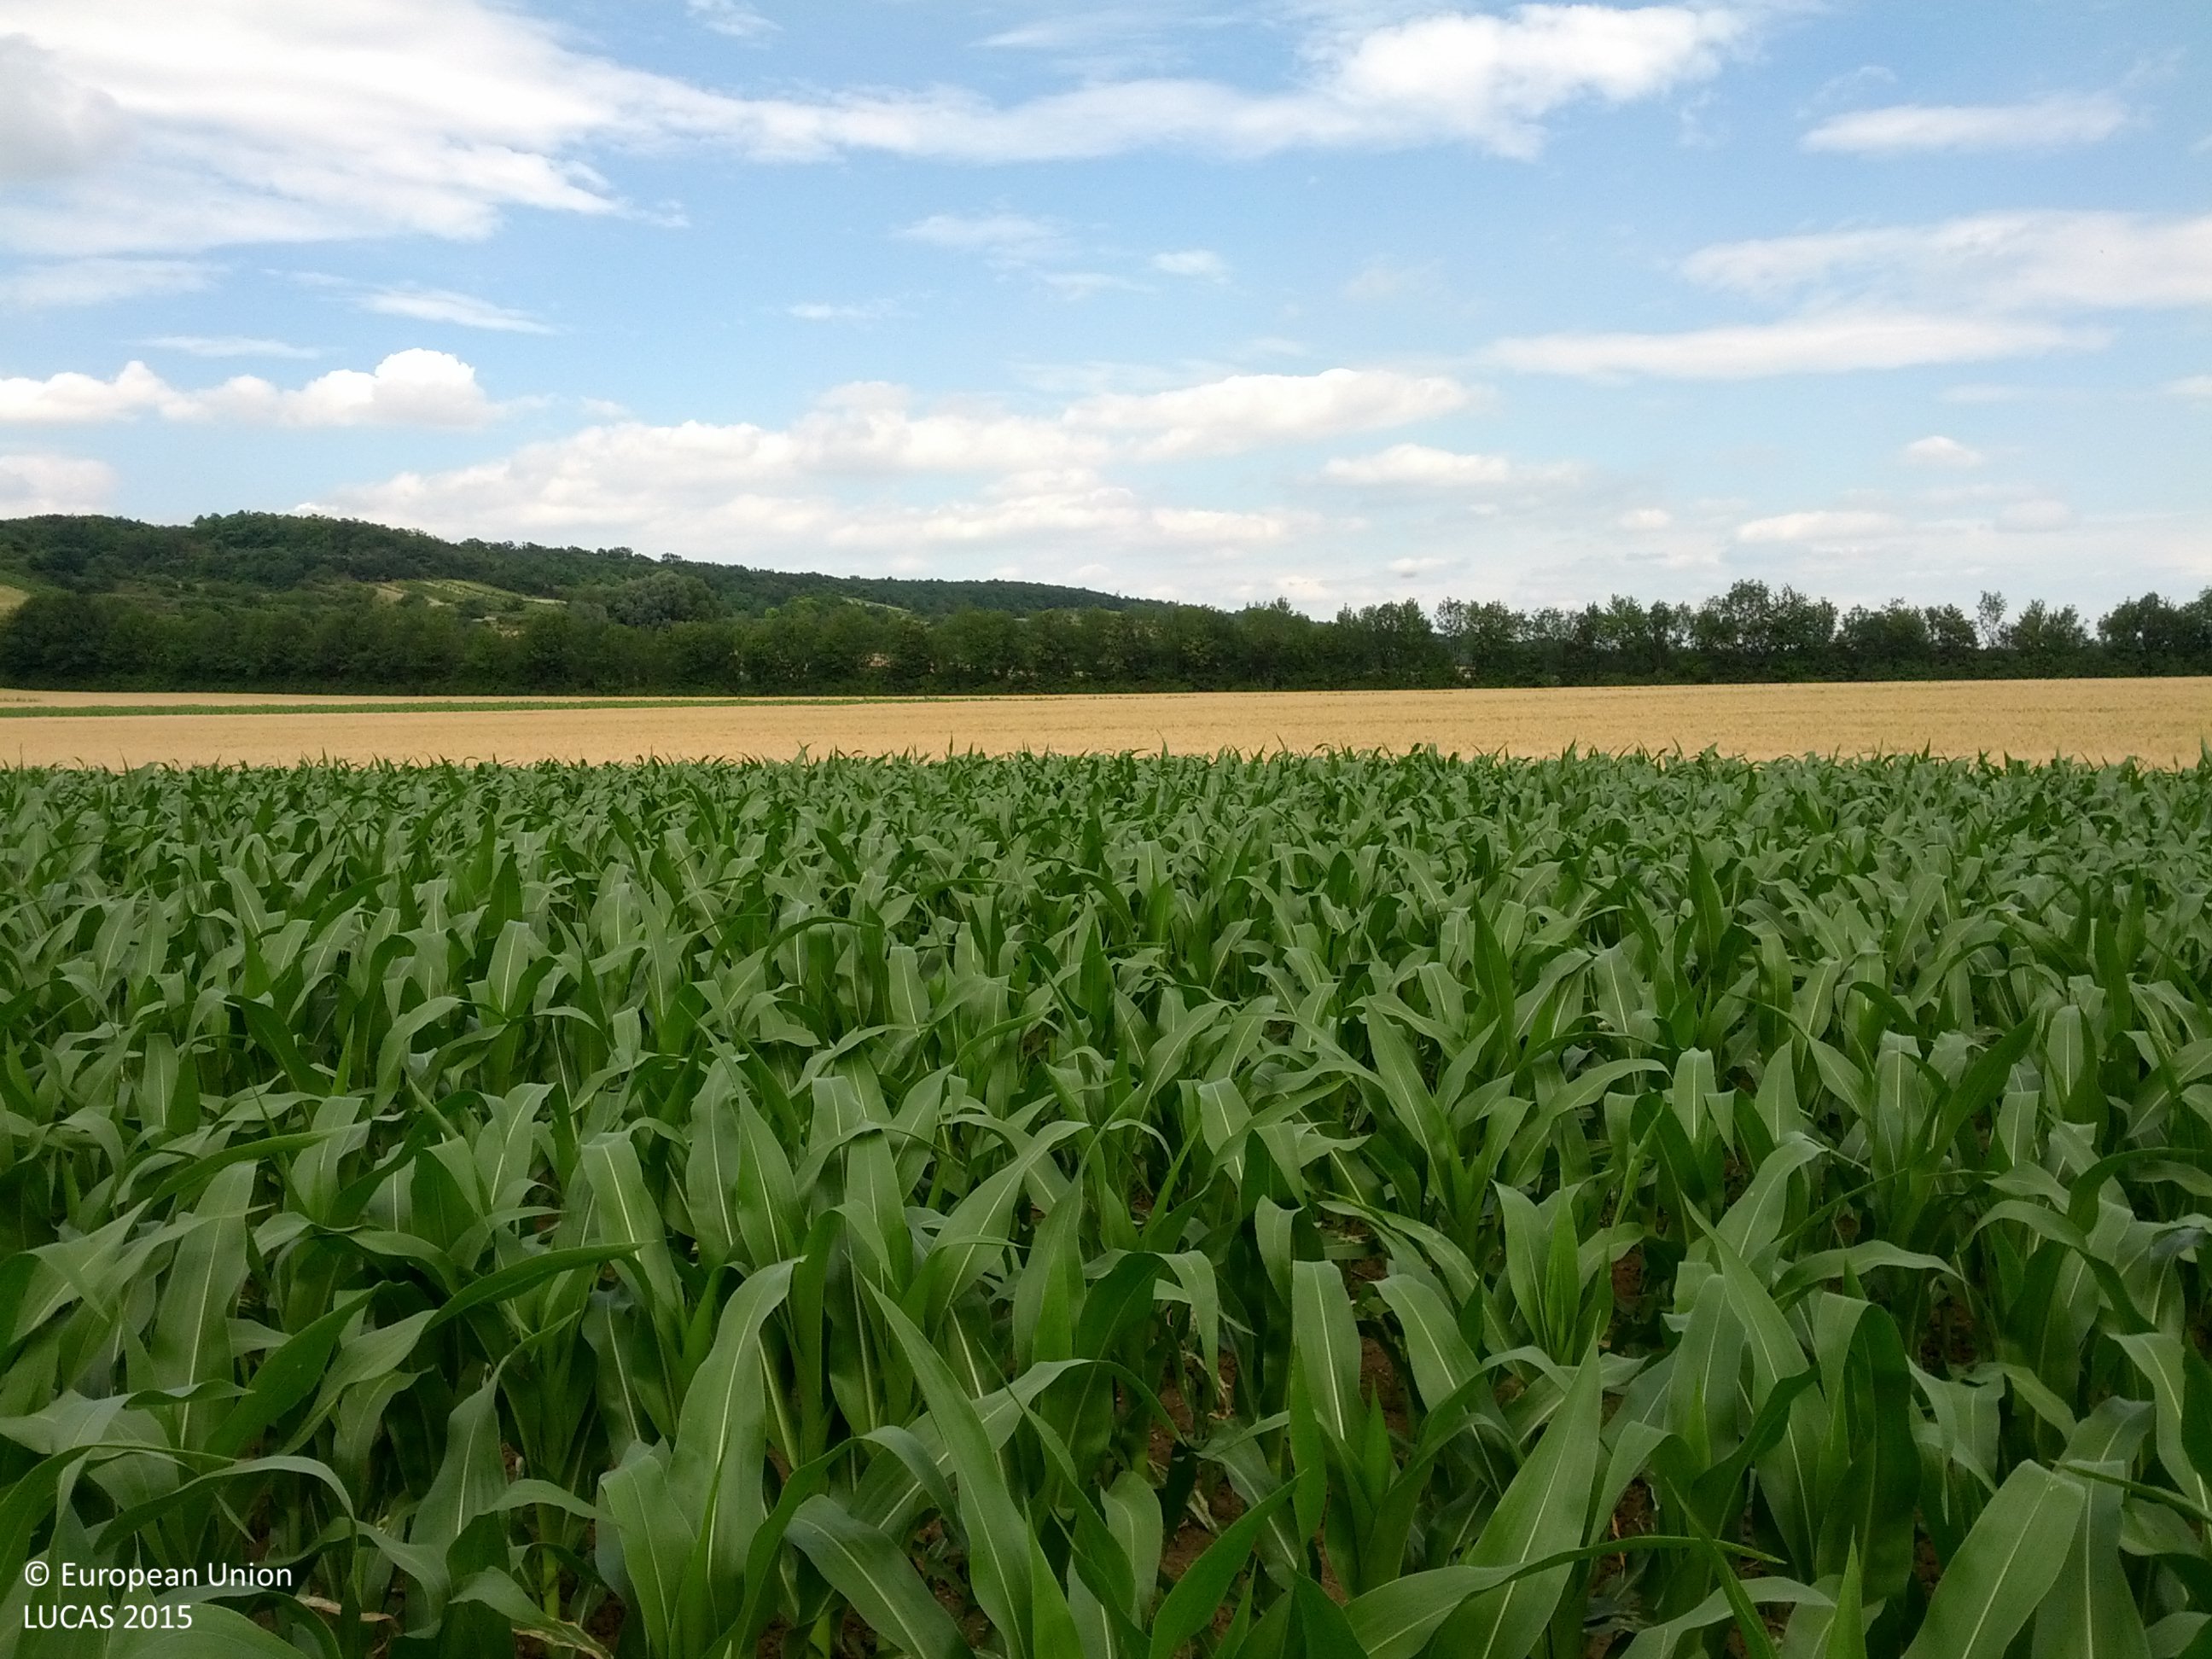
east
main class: Cropland
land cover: Maize
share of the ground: > 75 %
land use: Agriculture (excluding fallow land and kitchen gardens)
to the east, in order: Maize; Common wheat; Maize; Sunflower; Common wheat
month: June
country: AT
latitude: 48.4204
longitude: 16.6411
